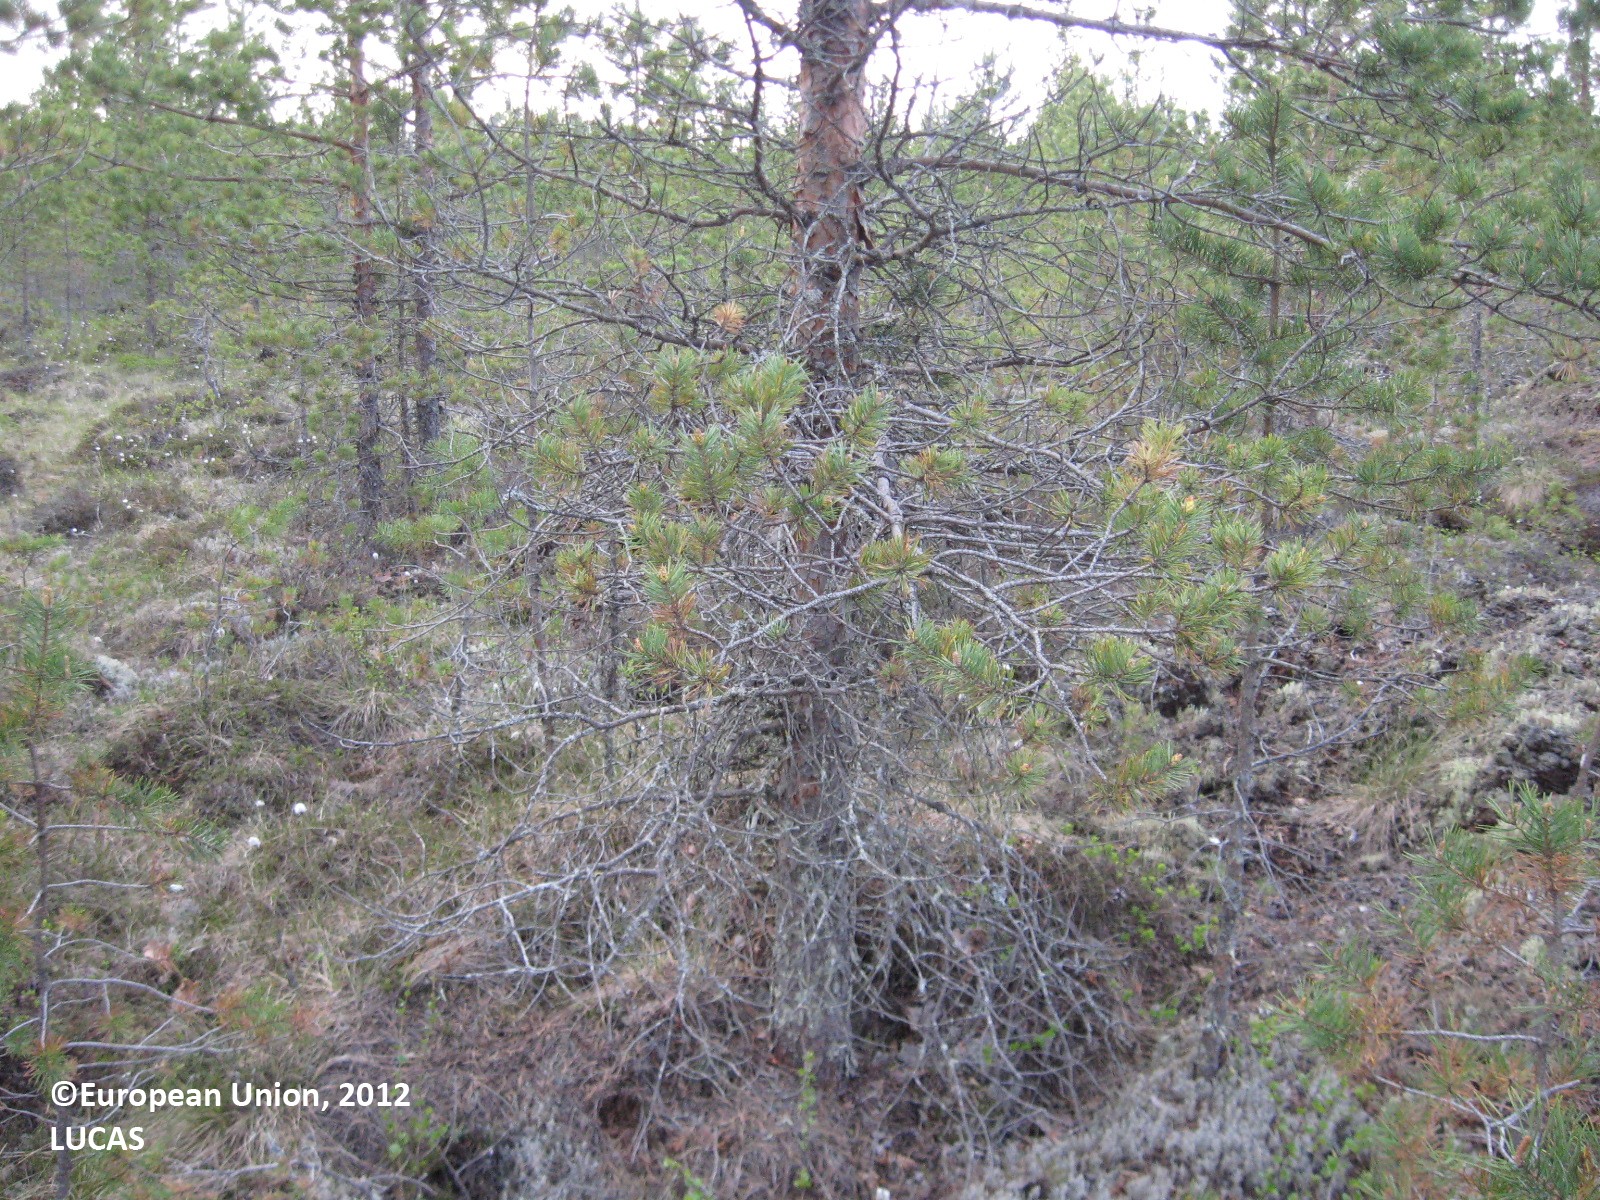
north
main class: Woodland
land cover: Pine dominated coniferous woodland
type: boreal forest
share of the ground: 50 - 75 %
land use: Forestry
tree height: < 5 m
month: June
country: FI
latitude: 63.4534
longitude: 22.8273
